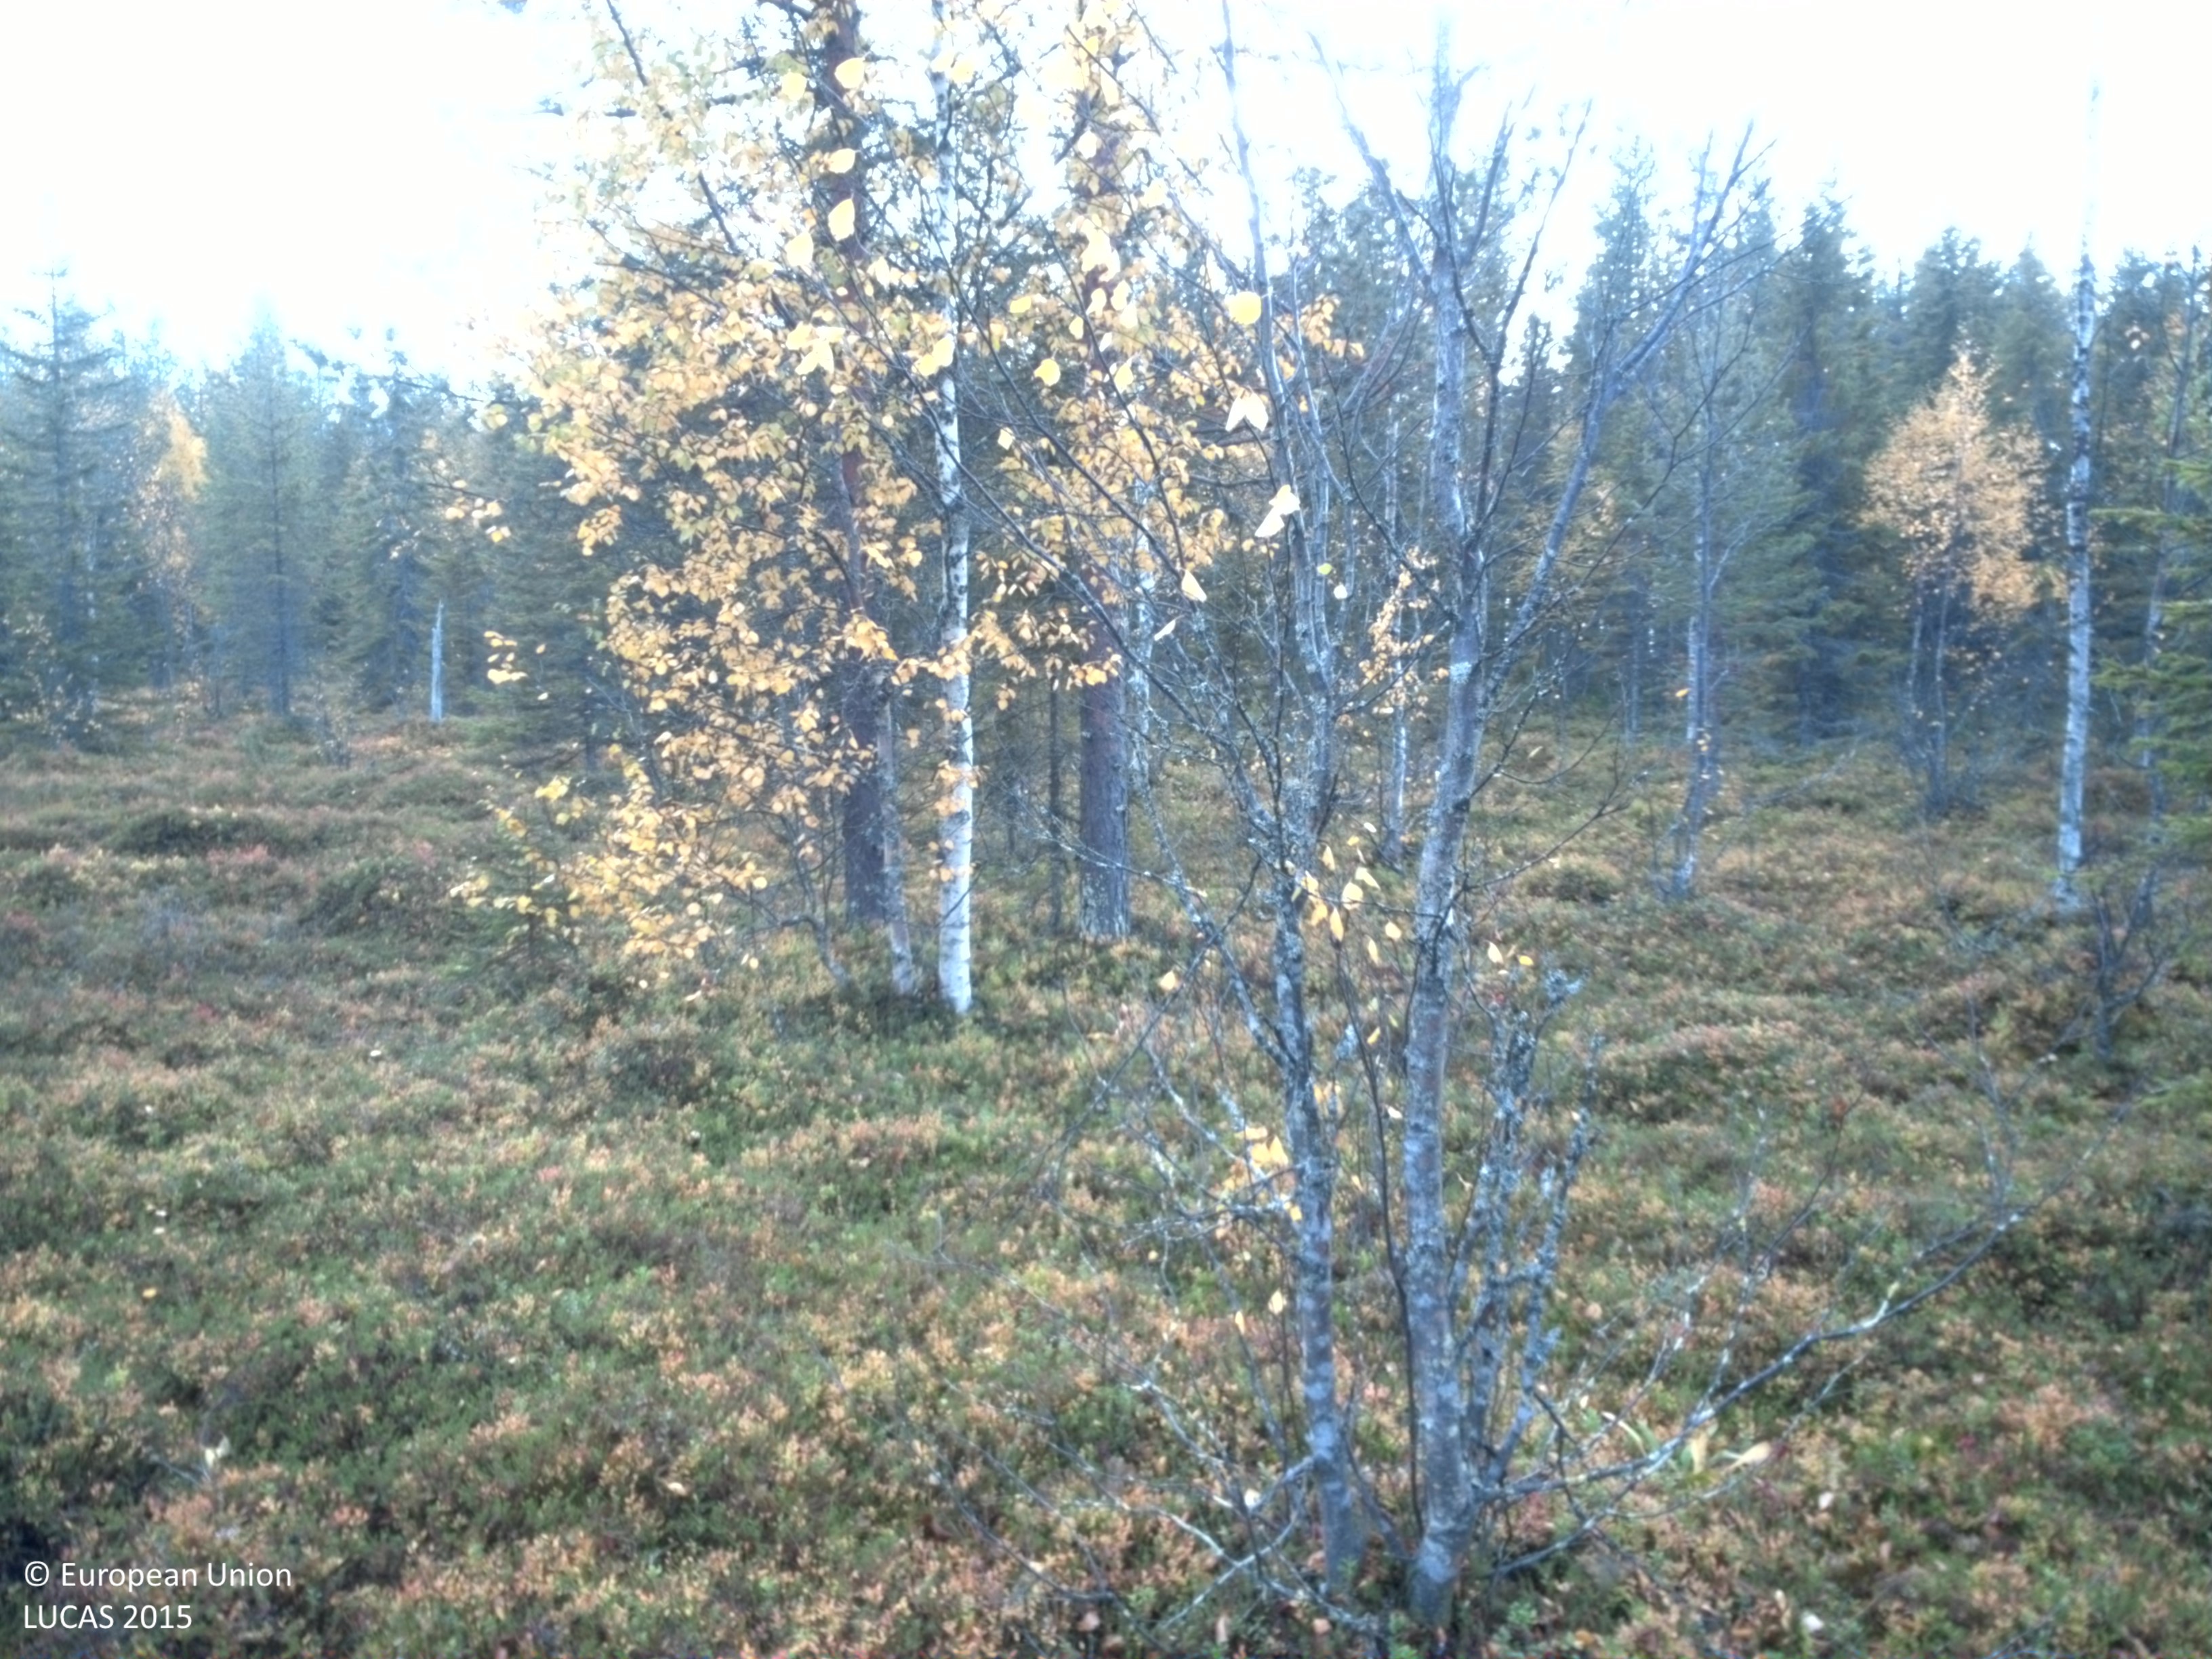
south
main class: Woodland
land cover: Other mixed woodland
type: boreal forest
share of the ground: 10 - 25 %
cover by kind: shrubs 55 %, lichens and mosses 20 %, coniferous forest trees 15 %, broadleaved forest trees 5 %, herbaceous plants 5 %
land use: Forestry
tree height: > 5 m
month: September
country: SE
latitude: 65.0357
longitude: 17.9265
